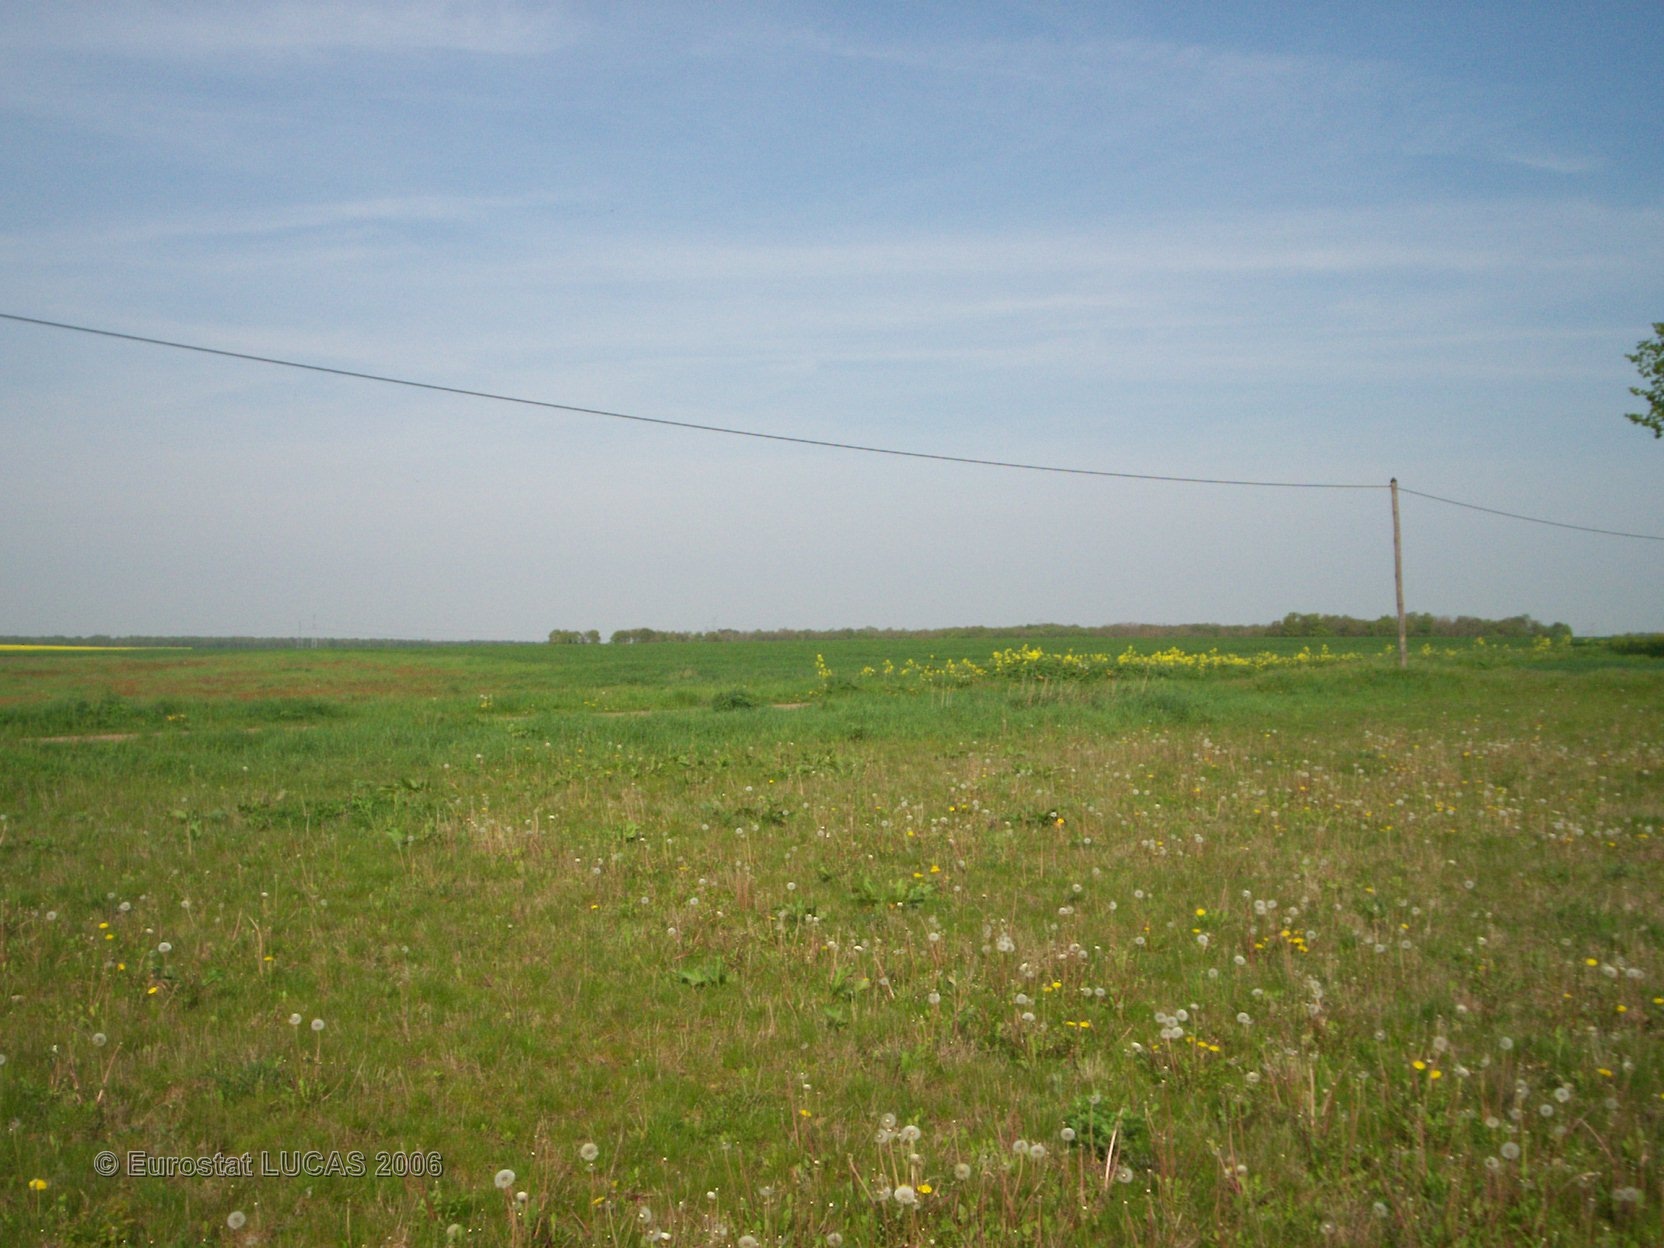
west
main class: Grassland
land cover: Grassland without tree/shrub cover
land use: Fallow land
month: May
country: FR
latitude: 48.0842
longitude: 2.8907
